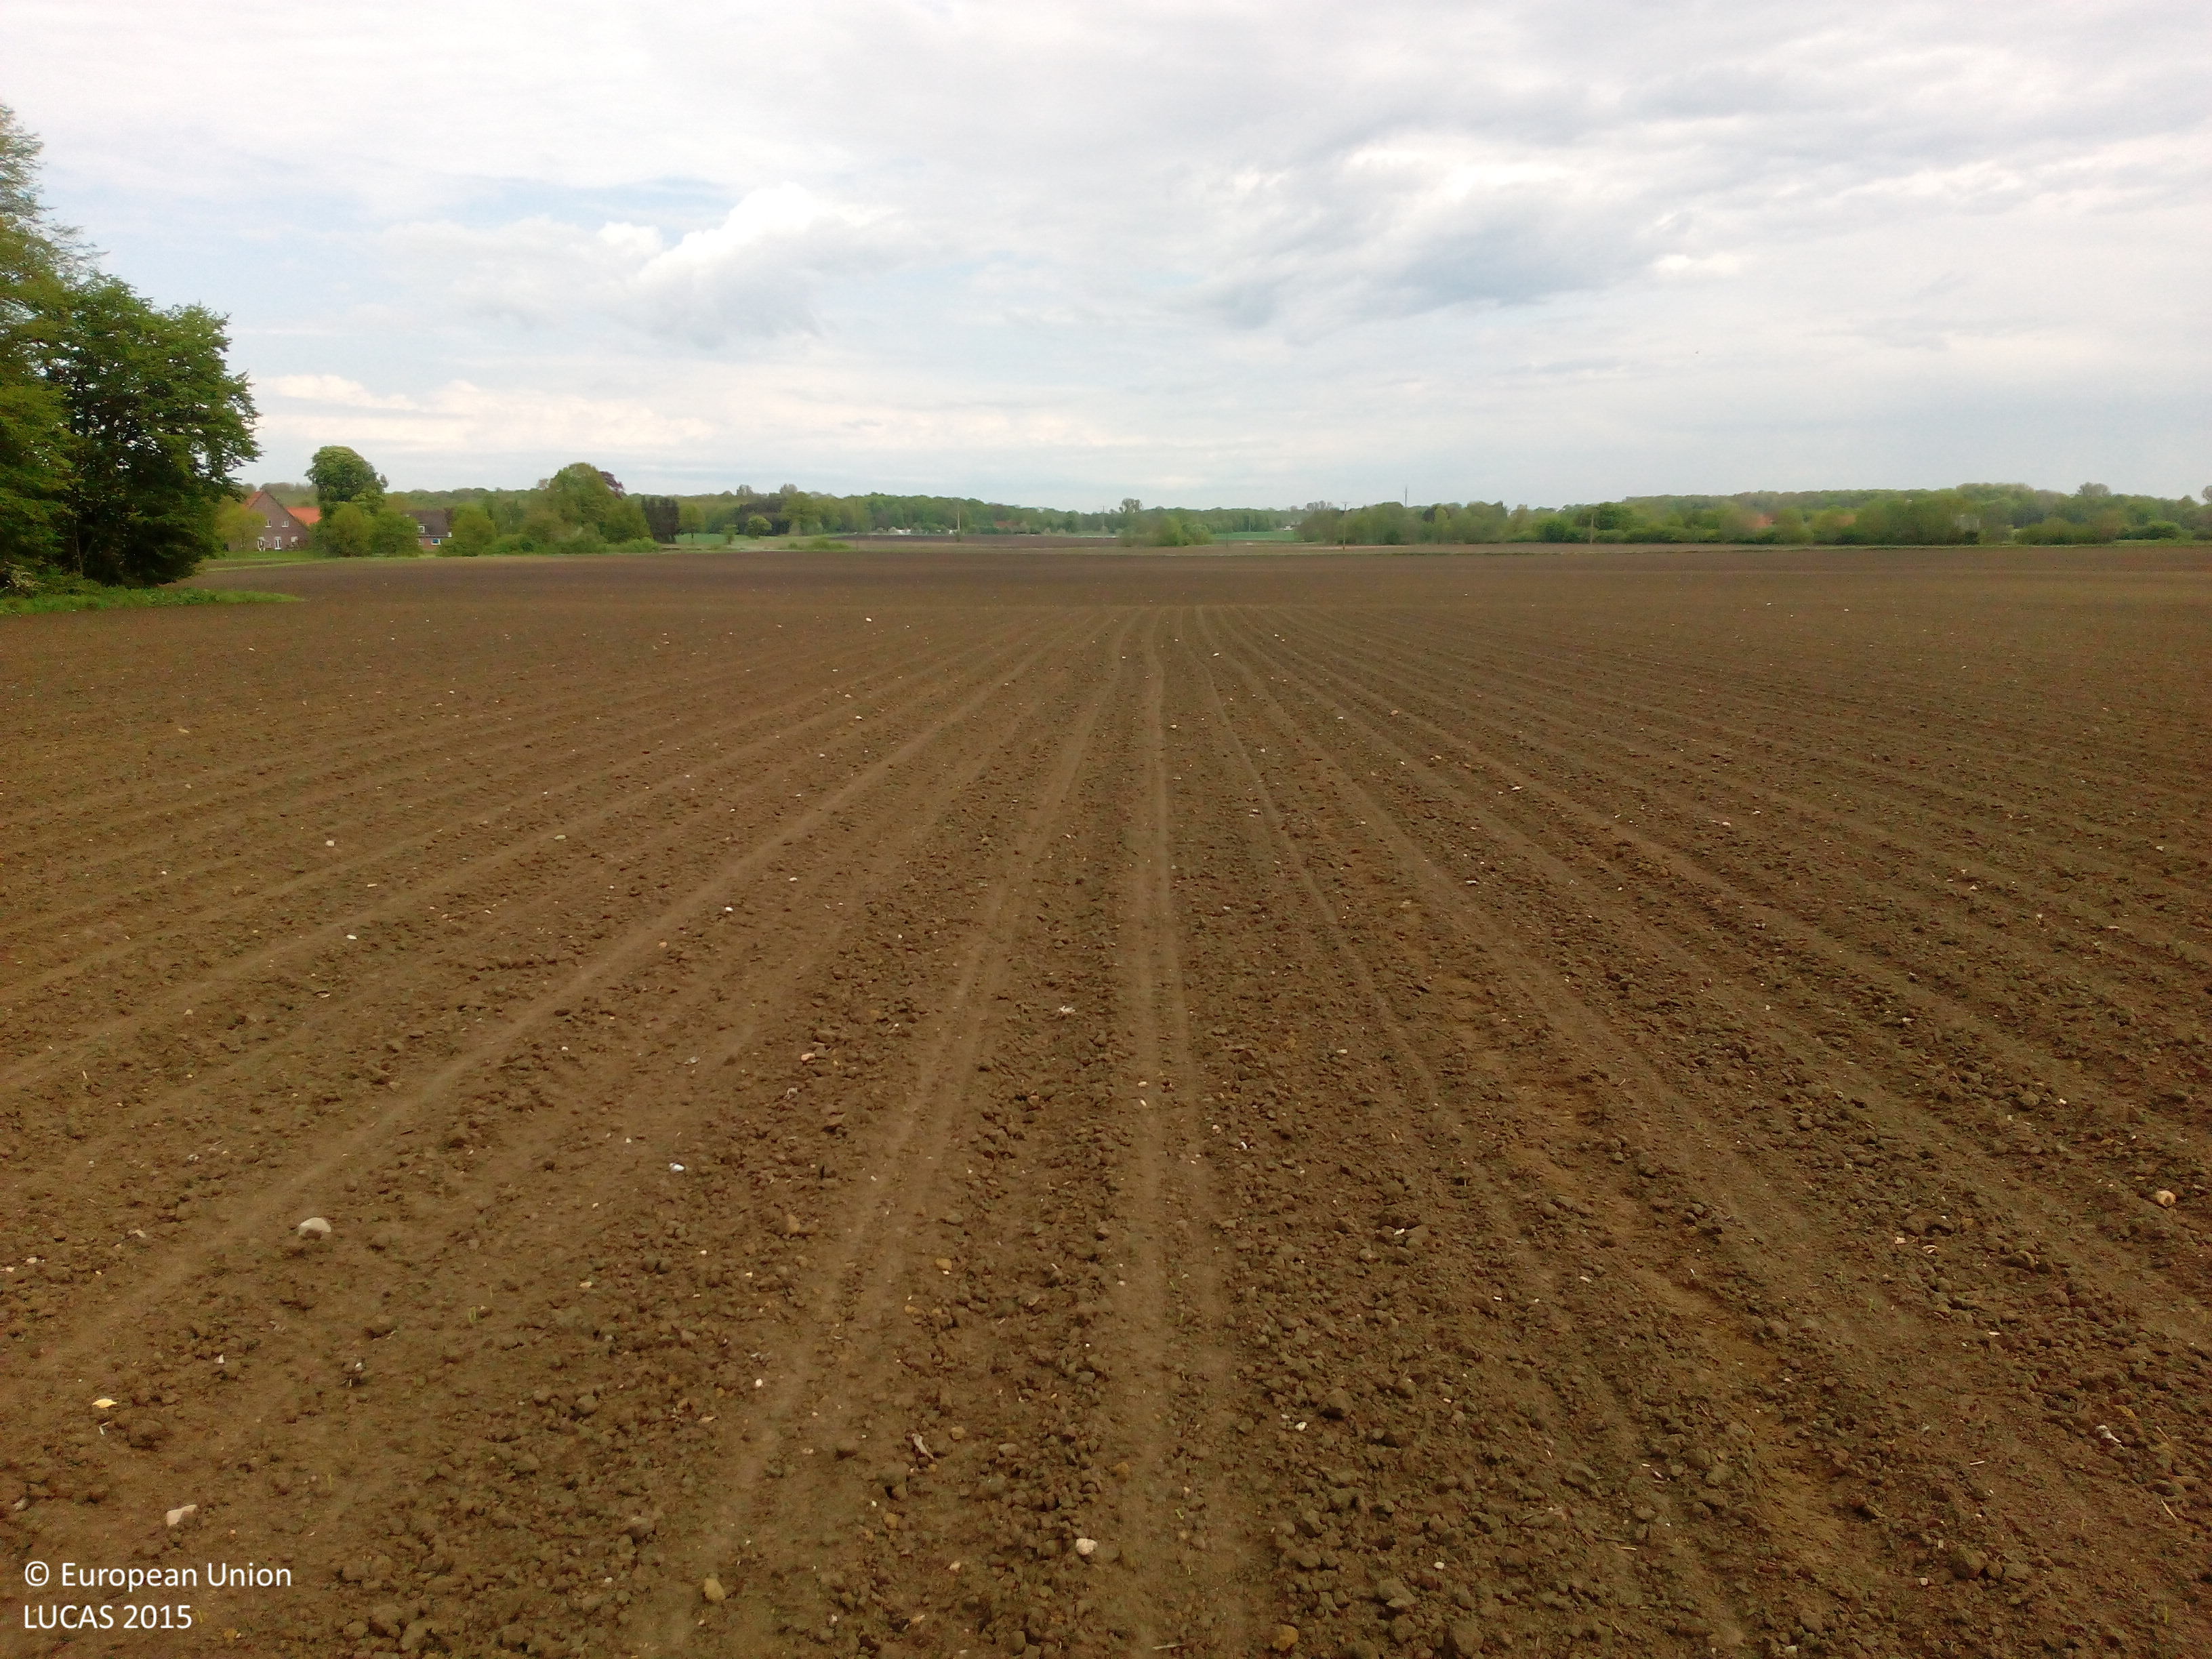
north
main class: Cropland
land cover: Maize
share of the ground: < 10 %
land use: Agriculture (excluding fallow land and kitchen gardens)
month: May
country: DE
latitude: 51.8288
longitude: 7.4610
